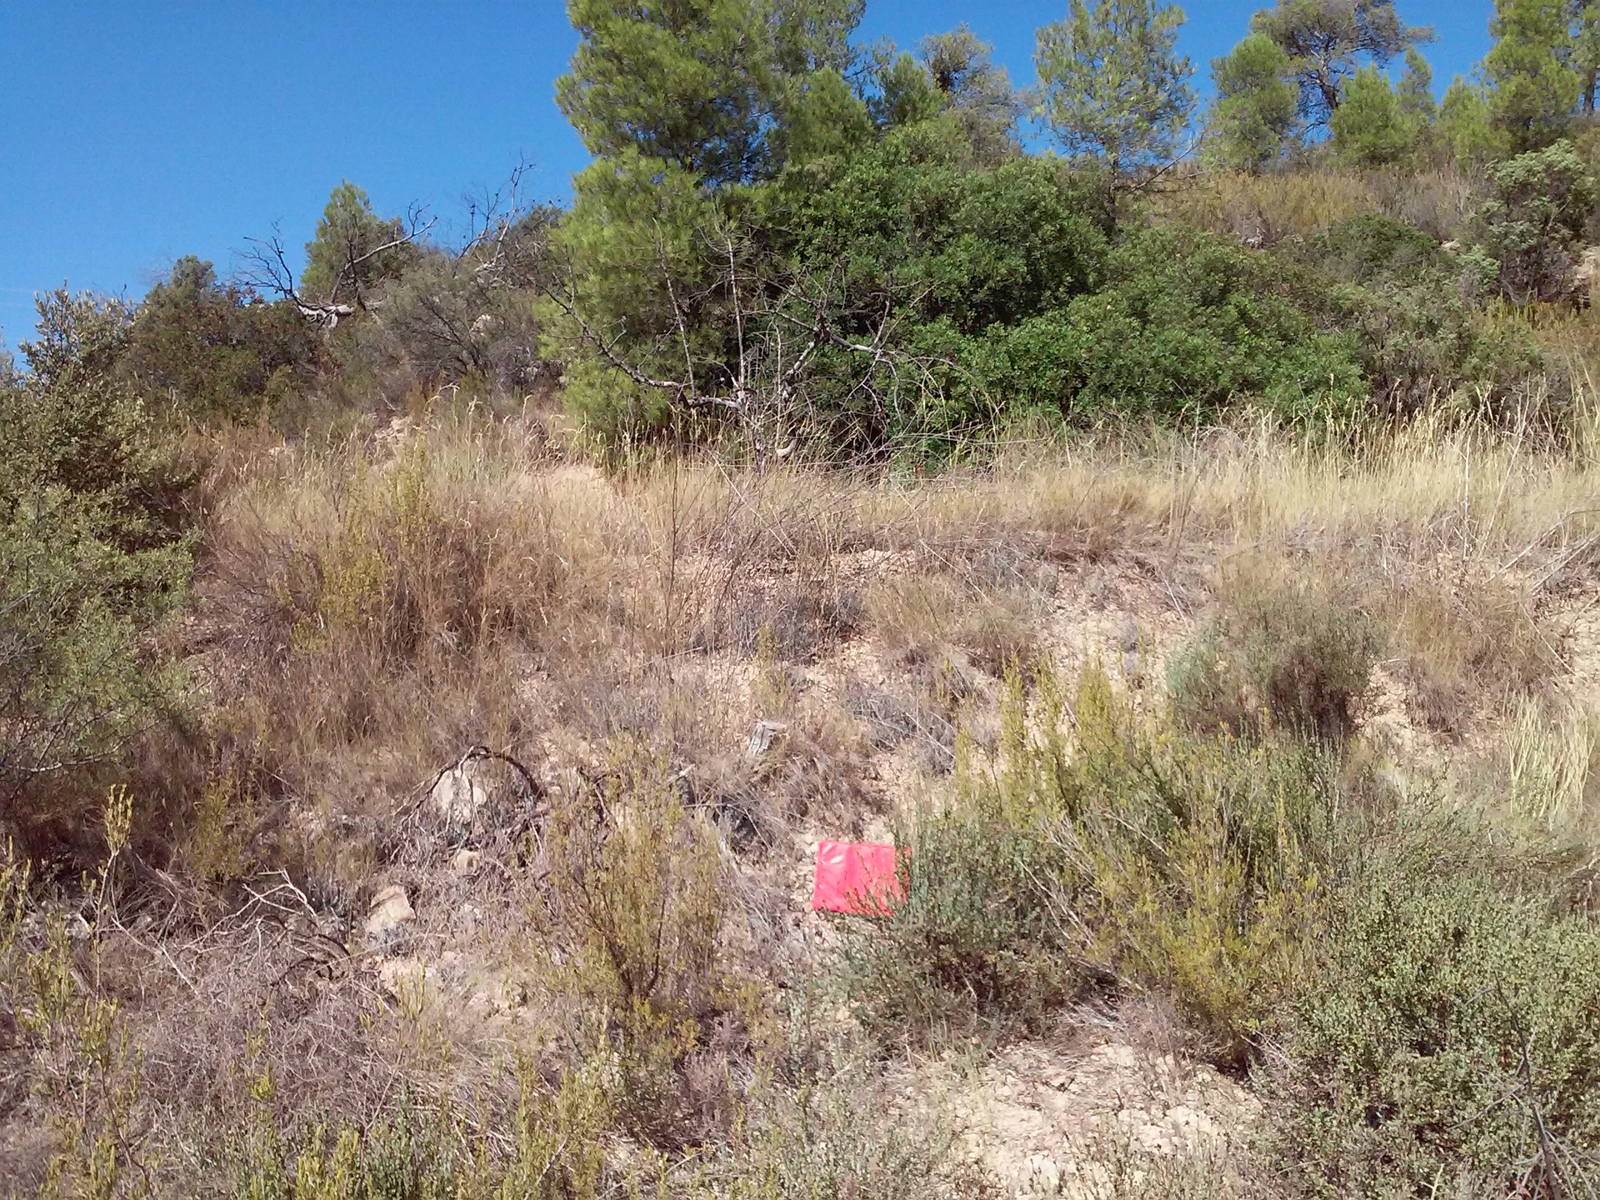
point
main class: Cropland
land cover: Nuts trees
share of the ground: 10 - 25 %
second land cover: Grassland without tree/shrub cover
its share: > 75 %
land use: Abandoned areas
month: September
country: ES
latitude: 41.2165
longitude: 0.6038
